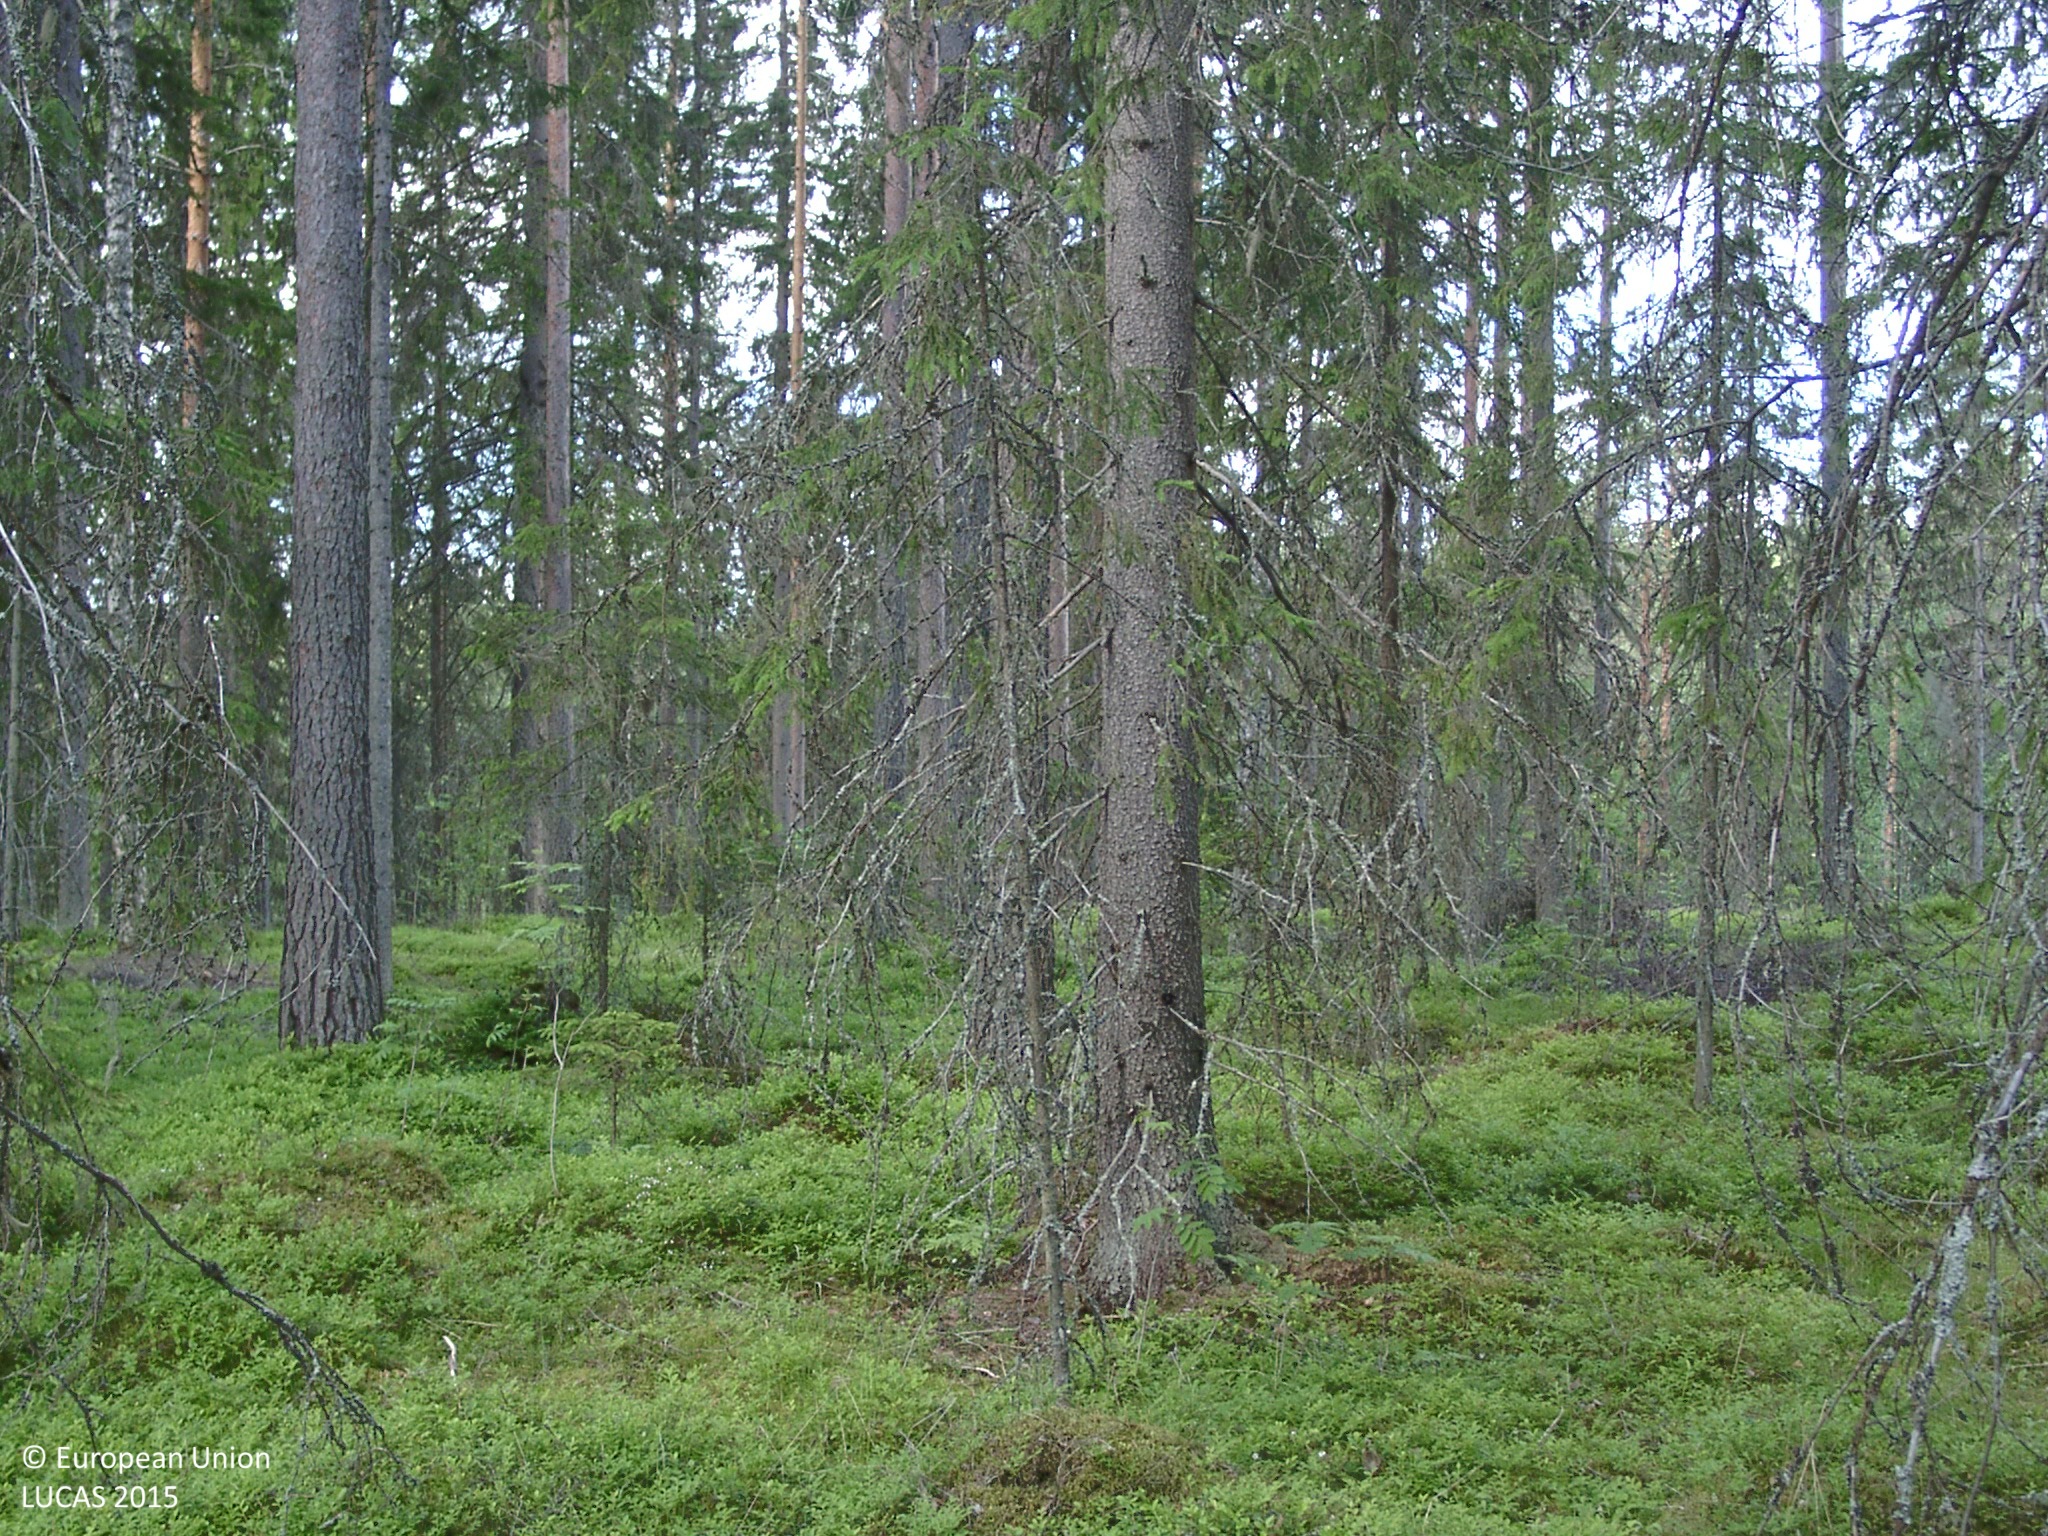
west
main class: Woodland
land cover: Other coniferous woodland
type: boreal forest
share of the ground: 50 - 75 %
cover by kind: coniferous forest trees 60 %, shrubs 30 %, broadleaved forest trees 5 %, herbaceous plants 5 %
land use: Forestry
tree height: > 5 m
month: June
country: FI
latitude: 62.0878
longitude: 25.0608
